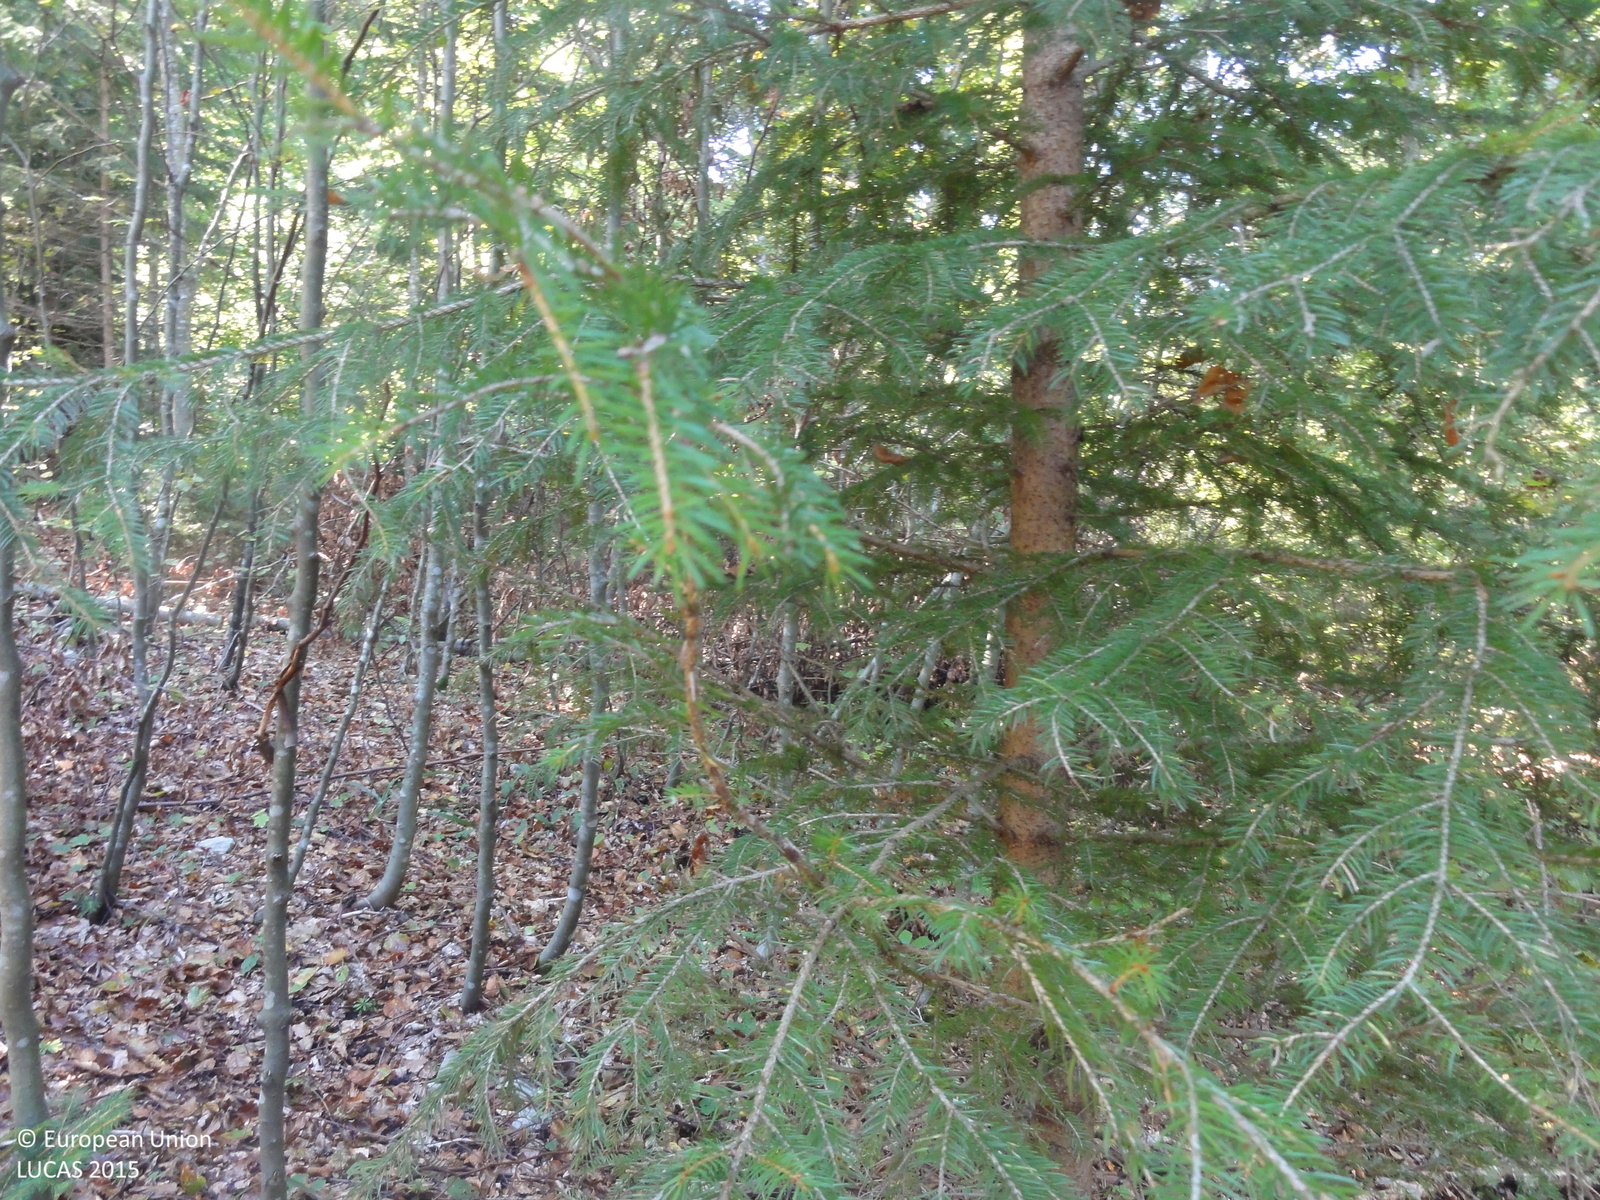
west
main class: Woodland
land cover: Spruce dominated mixed woodland
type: mountainous beech forest
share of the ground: > 75 %
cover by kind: broadleaved forest trees 50 %, coniferous forest trees 30 %, herbaceous plants 10 %, consolidated bare surface 5 %, unconsolidated bare surface 5 %
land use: Forestry
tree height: > 5 m
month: September
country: SI
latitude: 45.7112
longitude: 14.9931
